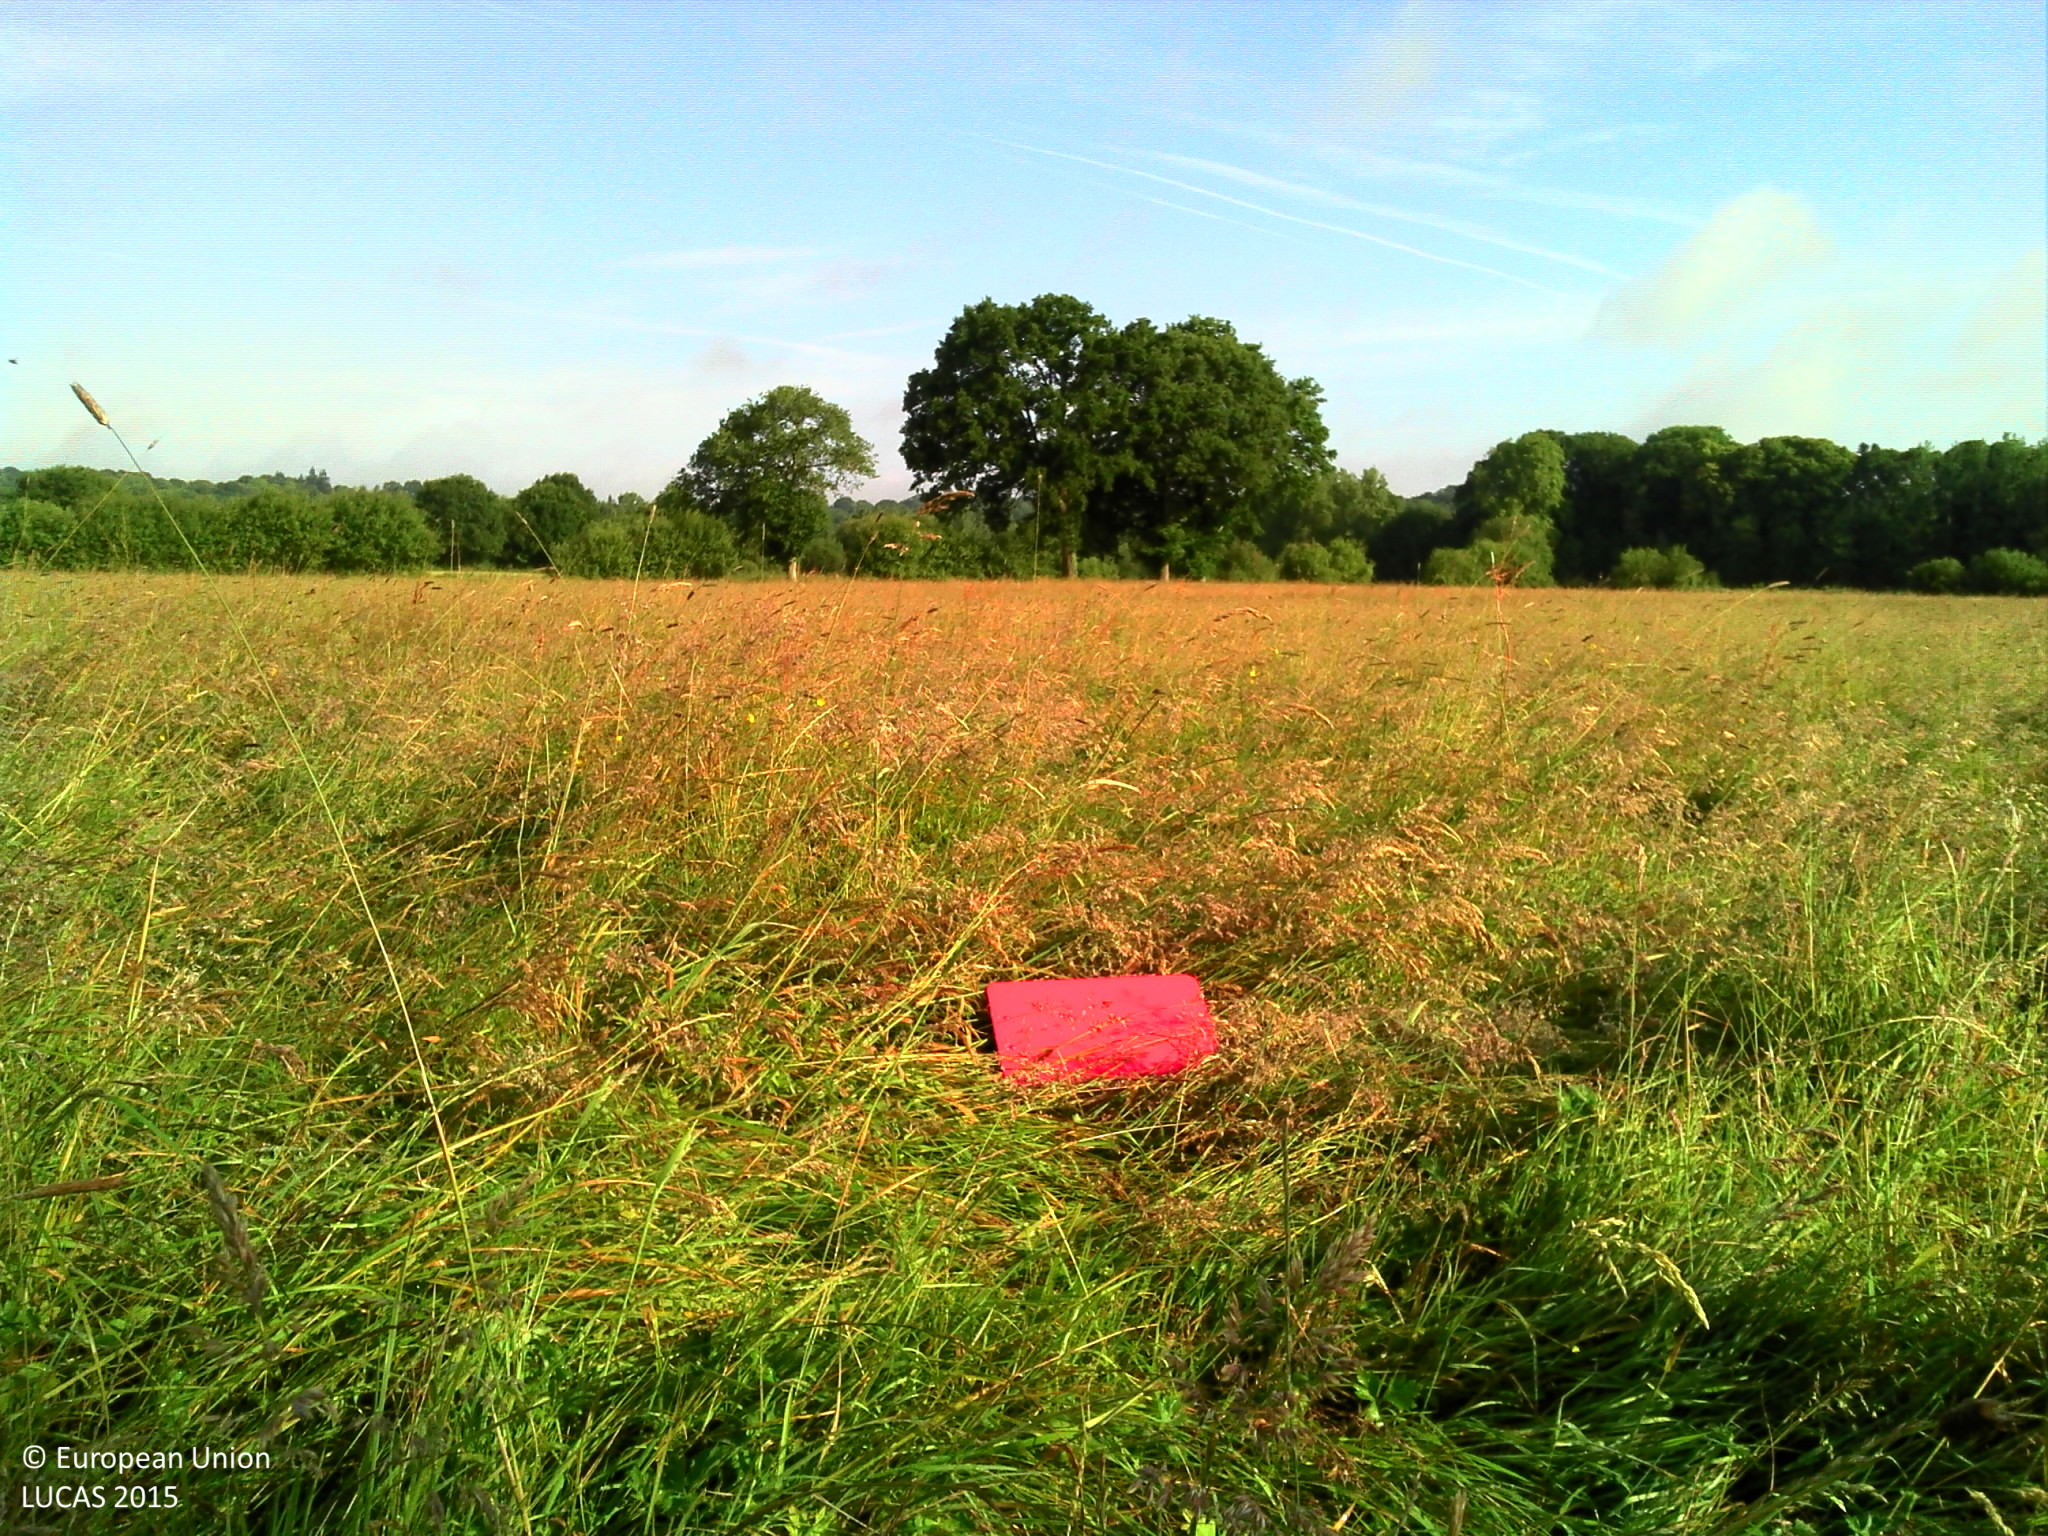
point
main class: Grassland
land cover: Grassland without tree/shrub cover
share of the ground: > 75 %
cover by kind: herbaceous plants 100 %
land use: Agriculture (excluding fallow land and kitchen gardens)
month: June
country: FR
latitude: 48.2547
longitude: -1.5083
